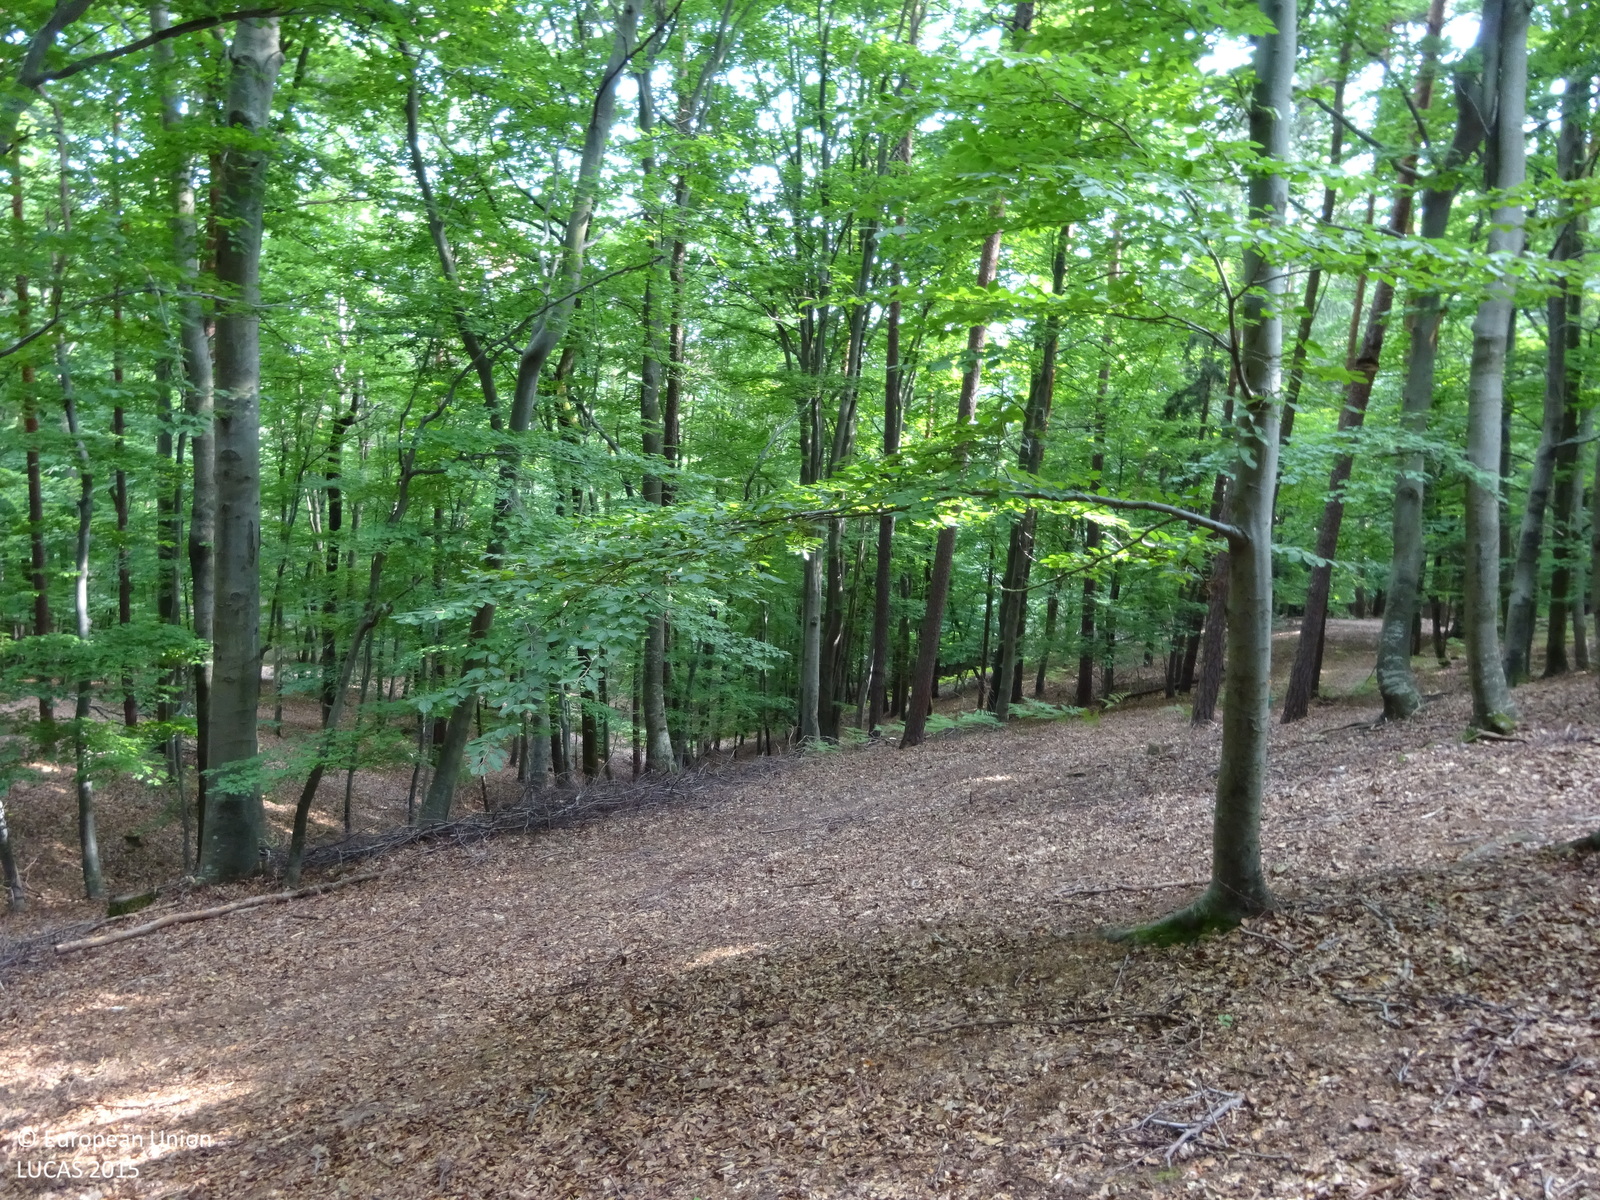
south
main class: Woodland
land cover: Broadleaved woodland
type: mountainous beech forest
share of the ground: > 75 %
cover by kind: broadleaved forest trees 95 %, coniferous forest trees 5 %
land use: Forestry
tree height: > 5 m
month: June
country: AT
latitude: 46.7809
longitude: 15.9599
